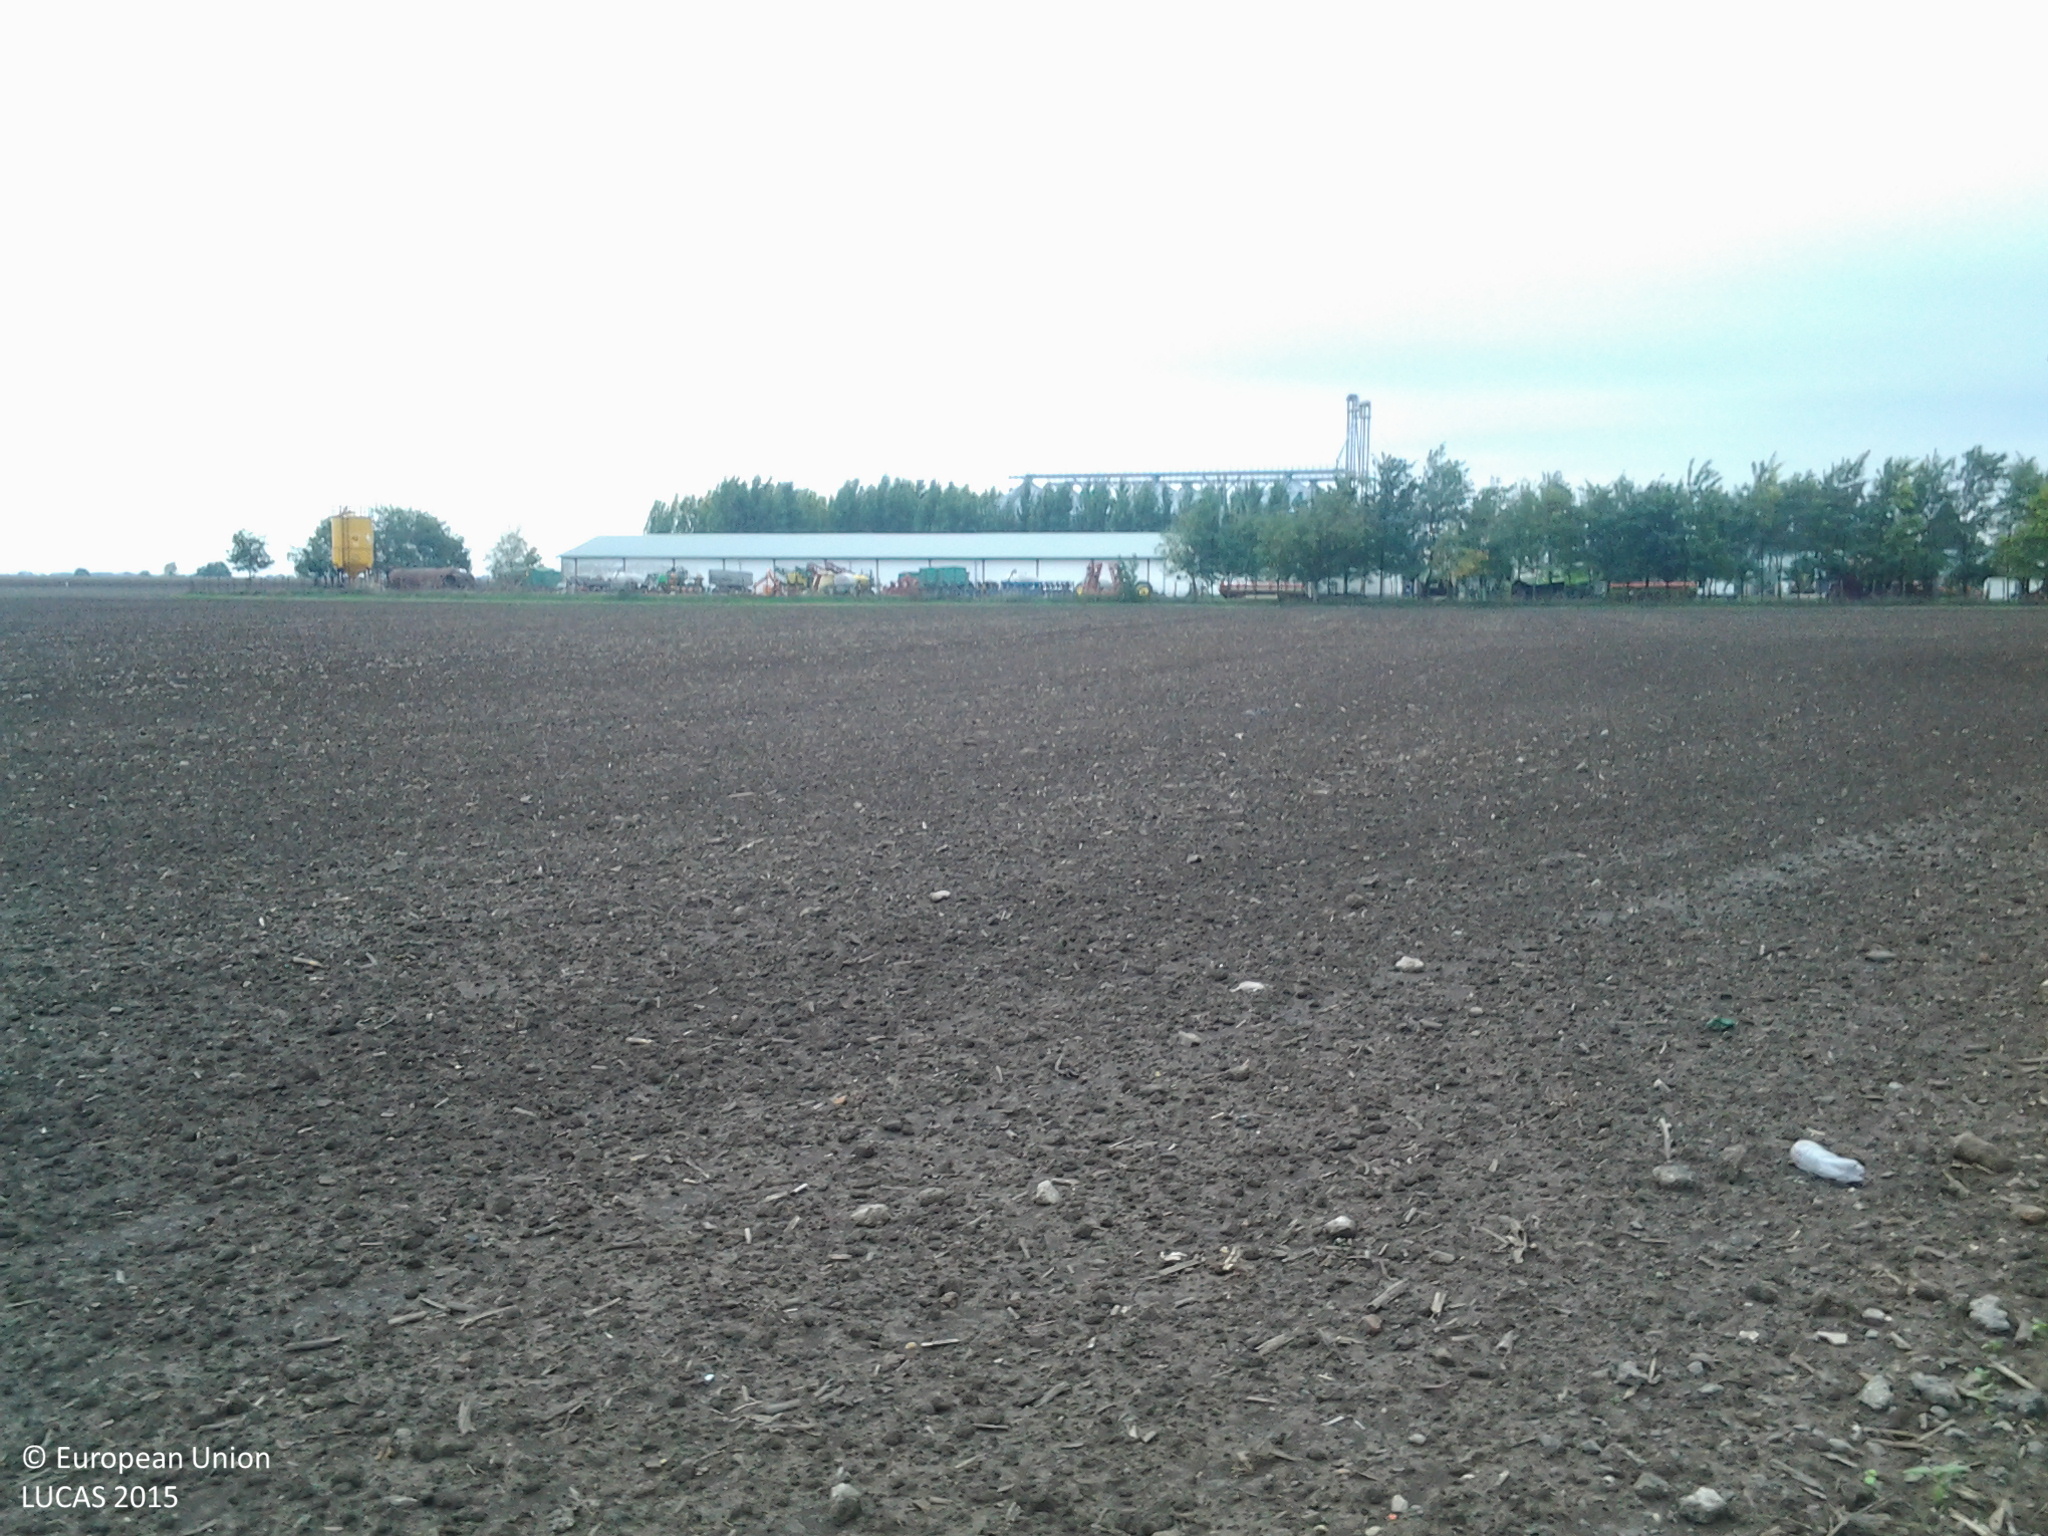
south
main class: Grassland
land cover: Grassland without tree/shrub cover
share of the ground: > 75 %
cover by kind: herbaceous plants 100 %
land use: Agriculture (excluding fallow land and kitchen gardens)
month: October
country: HU
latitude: 45.9571
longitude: 18.9525
